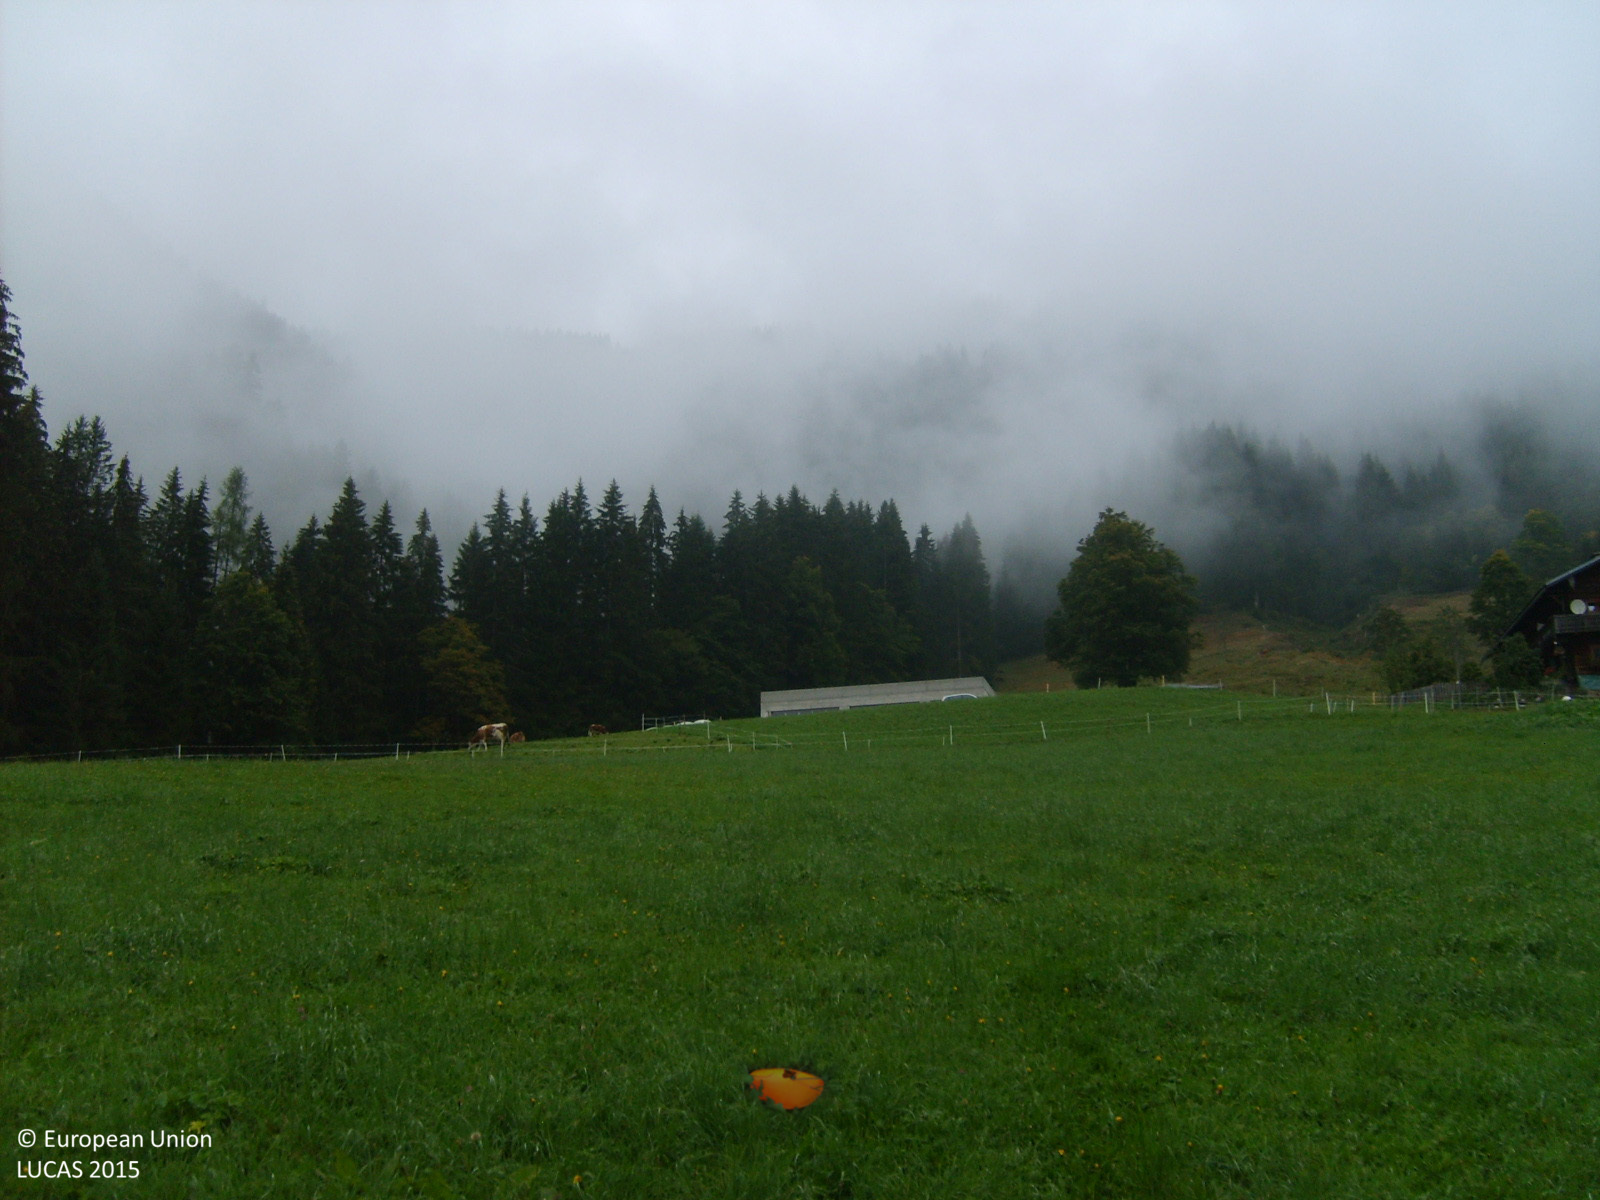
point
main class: Grassland
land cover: Grassland without tree/shrub cover
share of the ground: > 75 %
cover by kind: herbaceous plants 100 %
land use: Agriculture (excluding fallow land and kitchen gardens)
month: September
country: AT
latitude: 47.4357
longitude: 13.2997
